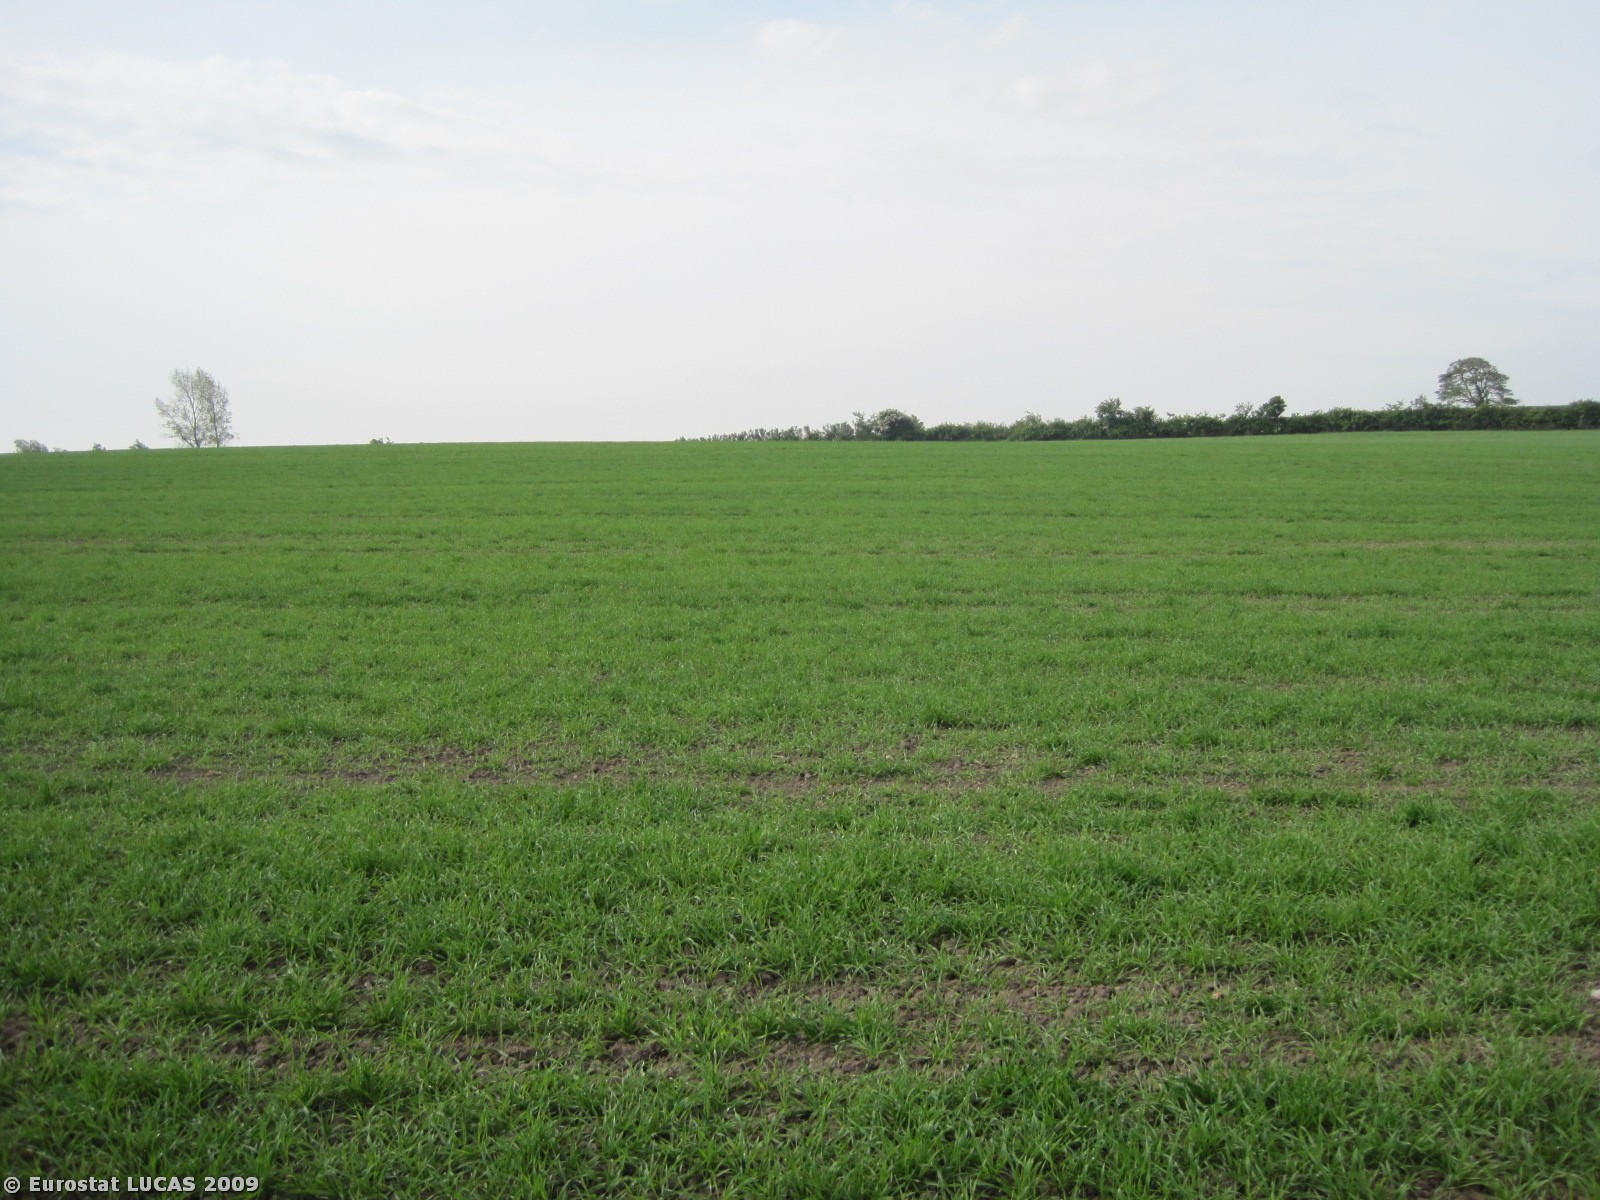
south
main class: Cropland
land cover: Barley
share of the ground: > 75 %
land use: Agriculture (excluding fallow land and kitchen gardens)
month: May
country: DK
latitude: 56.3855
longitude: 10.0162
